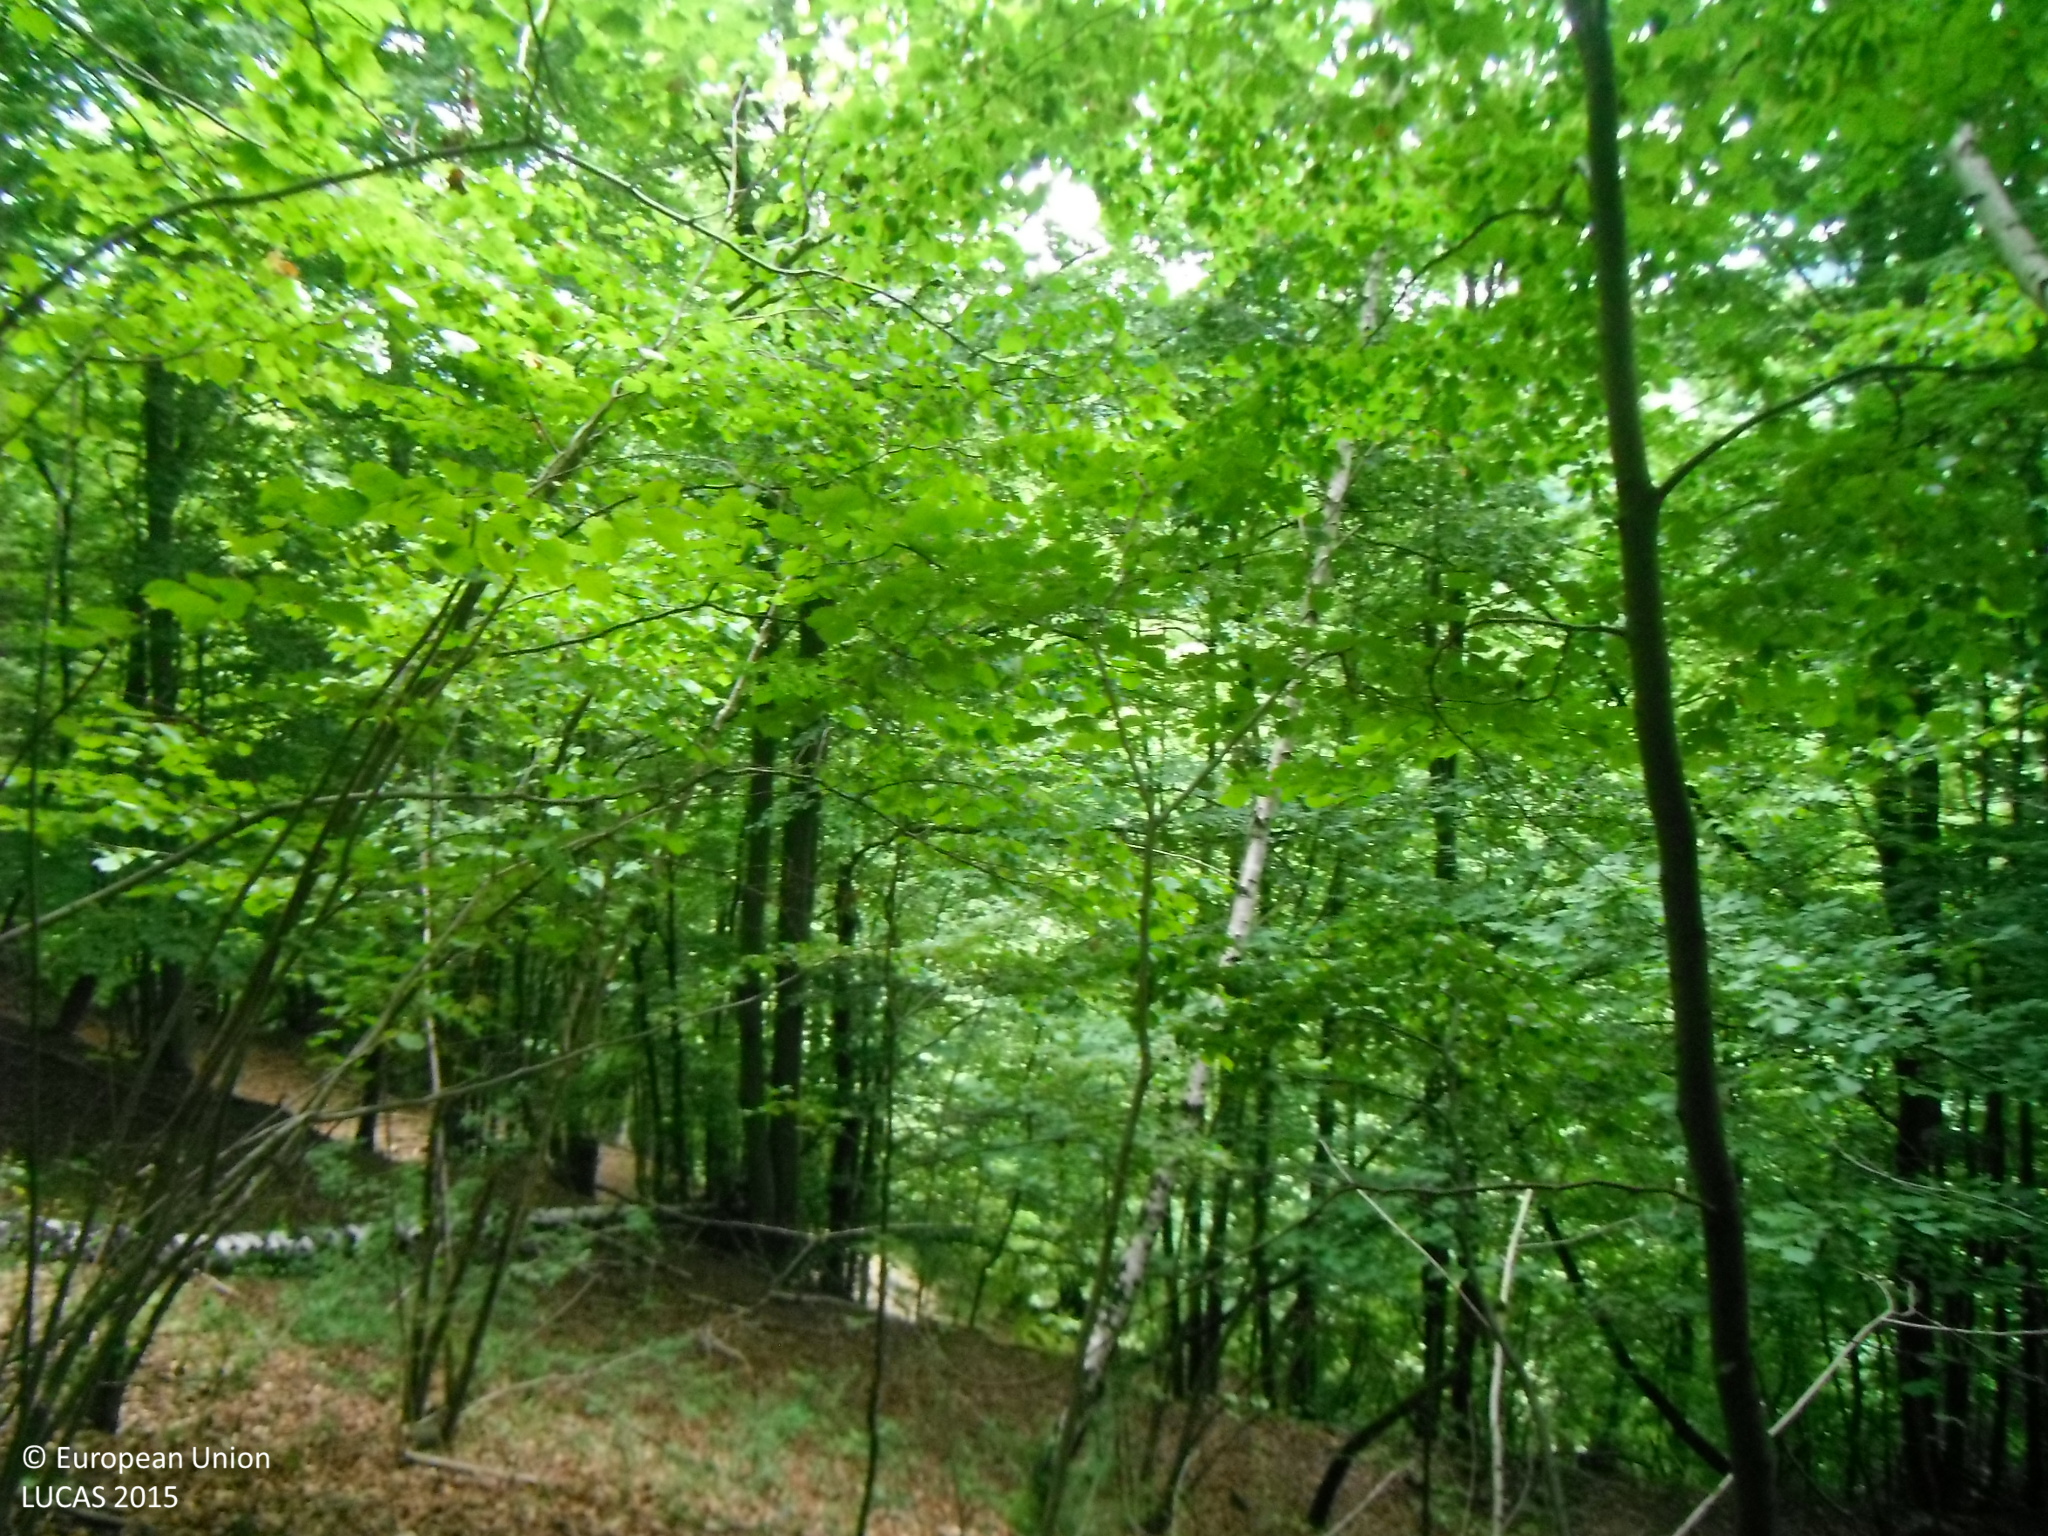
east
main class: Woodland
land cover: Broadleaved woodland
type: mountainous beech forest
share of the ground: > 75 %
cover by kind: broadleaved forest trees 95 %, unconsolidated bare surface 5 %
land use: Forestry
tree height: > 5 m
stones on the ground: > 50 %
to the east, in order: Broadleaved woodland; Shrubland without tree cover; Electric lines; Grassland with sparse tree/shrub cover; Shrubland with sparse tree cover; Rivers and streams; Electric lines; Grass margins; Artificial constructions in urban areas; Broadleaved woodland
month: July
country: SK
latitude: 49.2663
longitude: 18.3035
